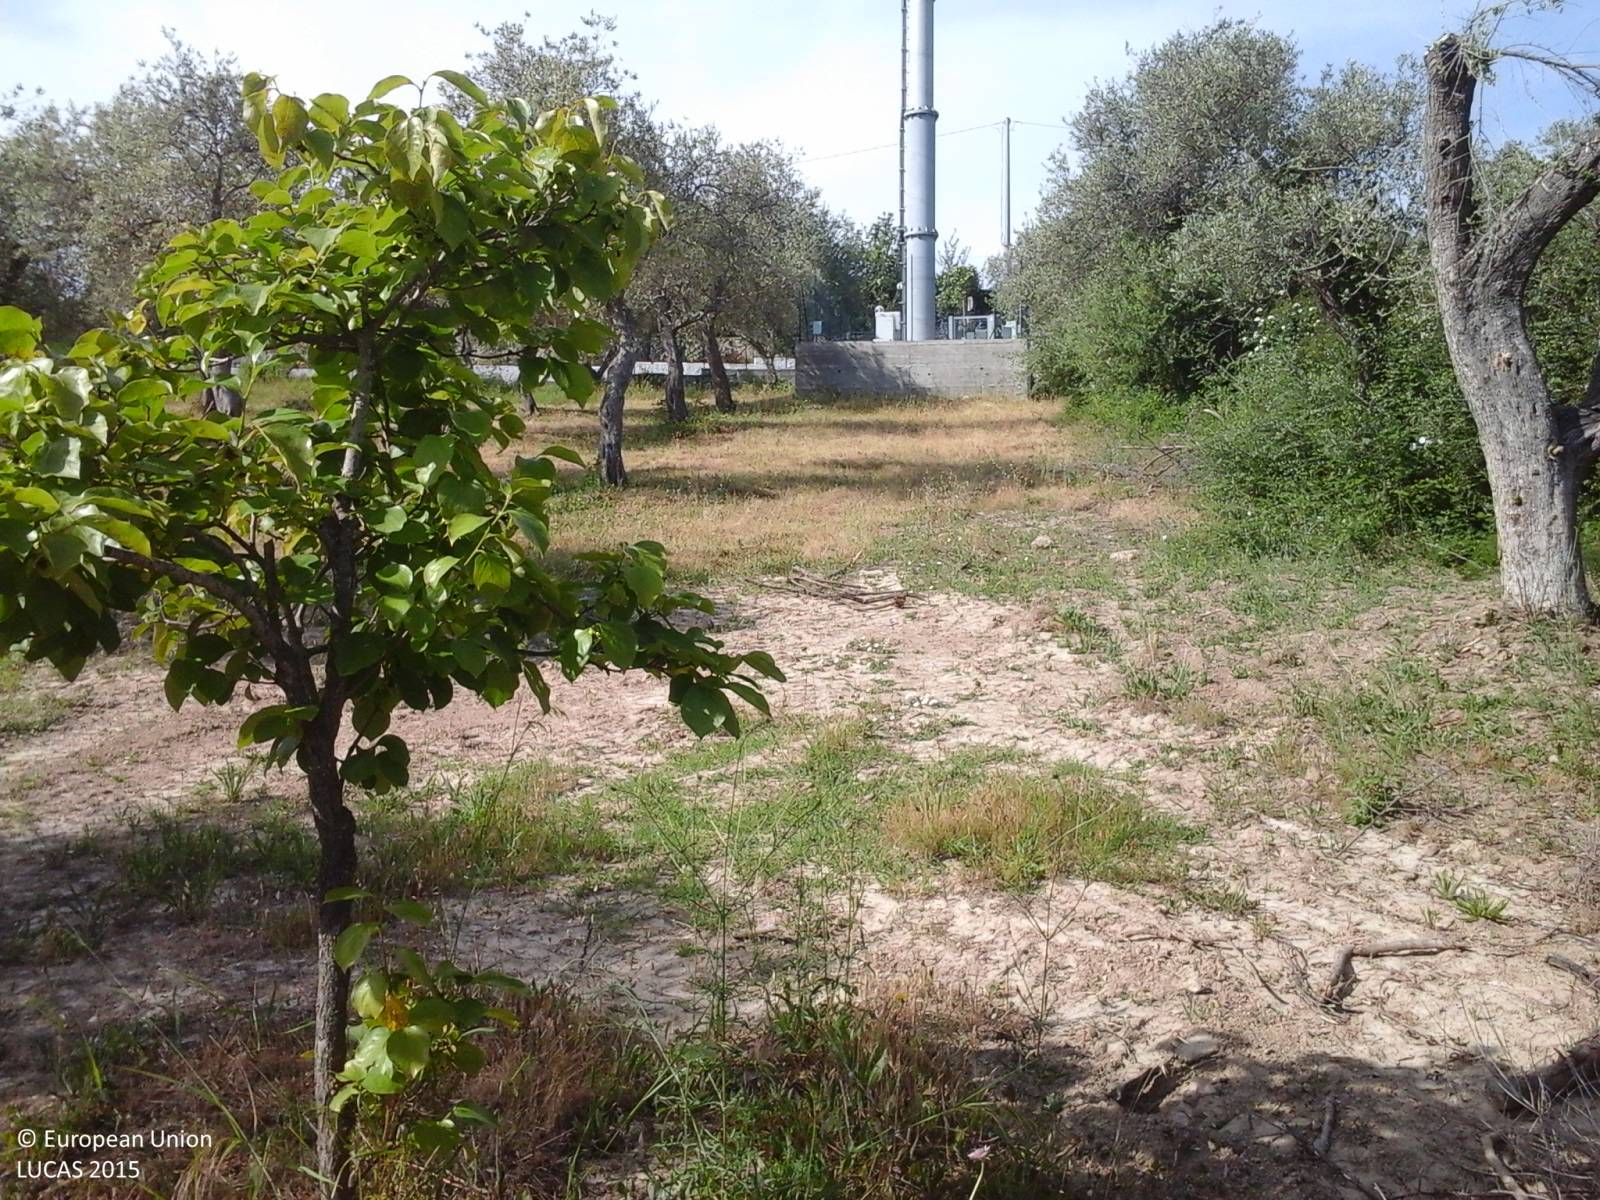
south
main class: Cropland
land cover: Olive groves
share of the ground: > 75 %
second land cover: Grassland without tree/shrub cover
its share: > 75 %
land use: Agriculture (excluding fallow land and kitchen gardens)
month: May
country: IT
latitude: 40.7638
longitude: 8.5734
